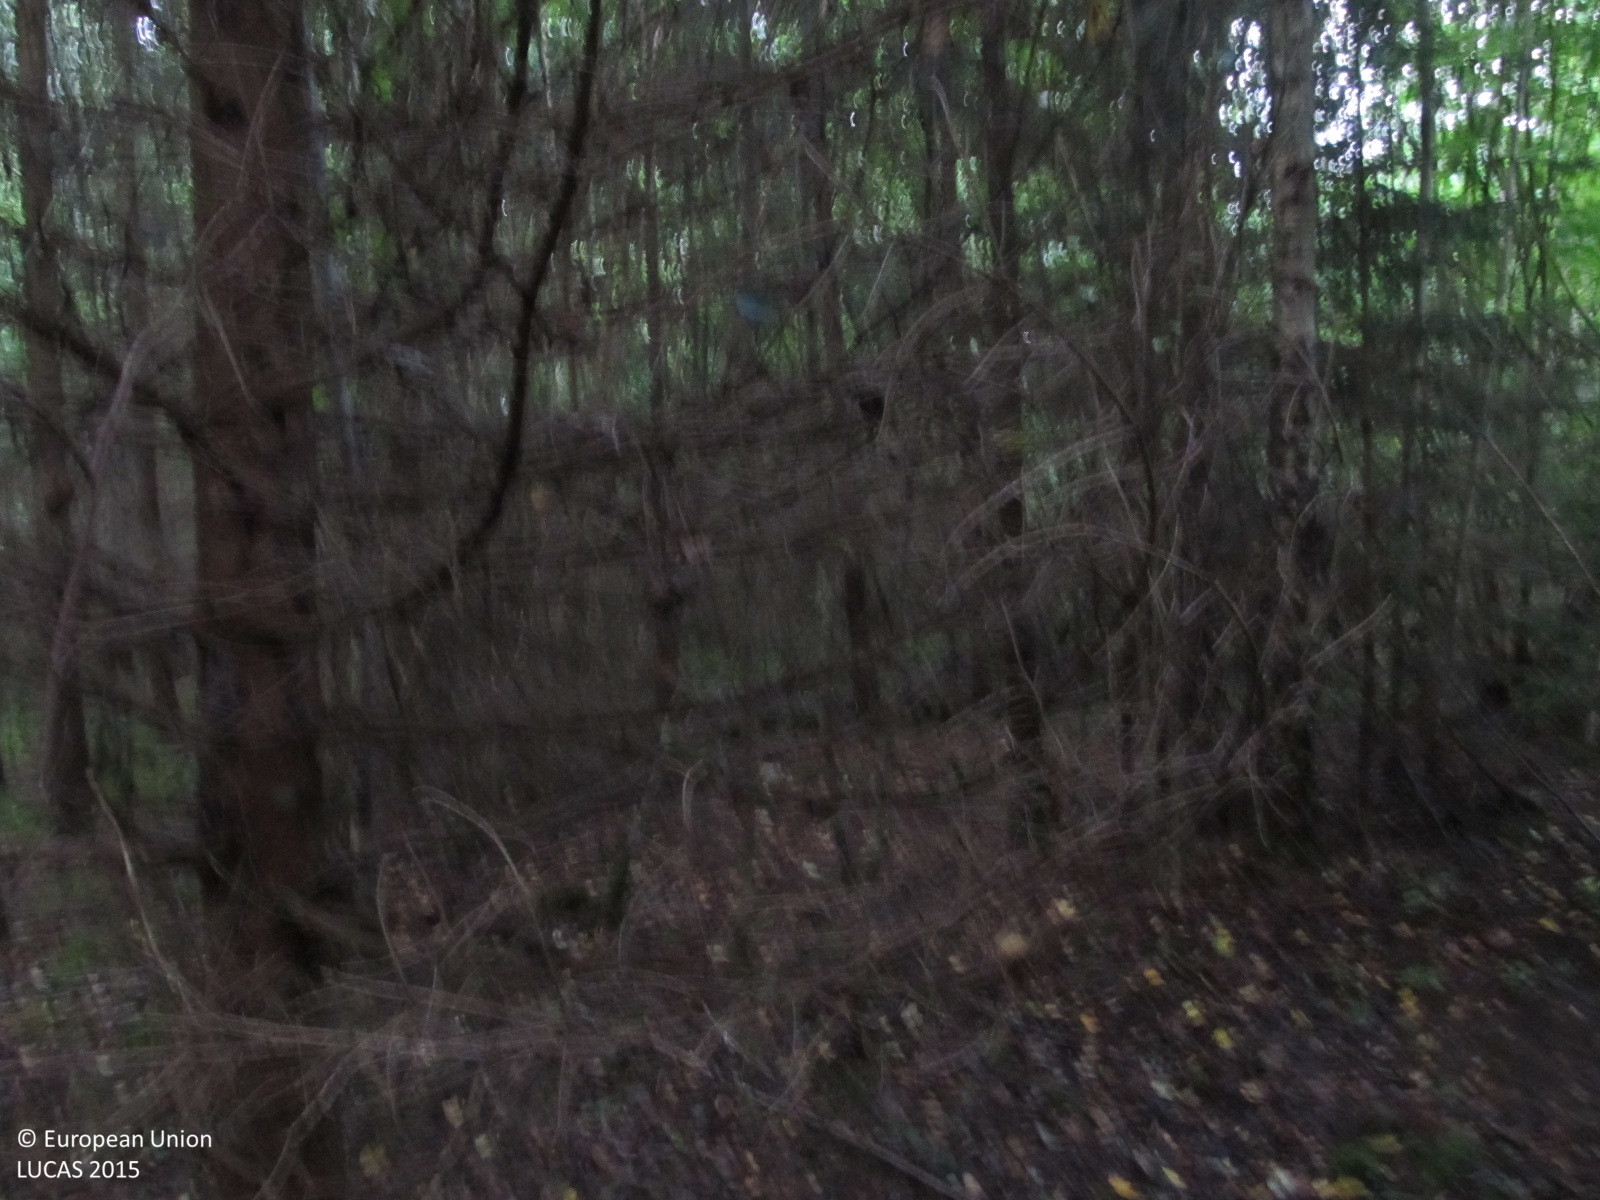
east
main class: Woodland
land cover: Spruce dominated mixed woodland
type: hemiboreal forest and nemoral coniferous forest and mixed broadleaved-coniferous forest
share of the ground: > 75 %
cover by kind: coniferous forest trees 55 %, broadleaved forest trees 40 %, lichens and mosses 5 %
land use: Forestry
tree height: > 5 m
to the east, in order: Spruce dominated mixed woodland; Tracks; Spruce dominated mixed woodland; Broadleaved woodland
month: September
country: LT
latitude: 56.2189
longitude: 23.1479
